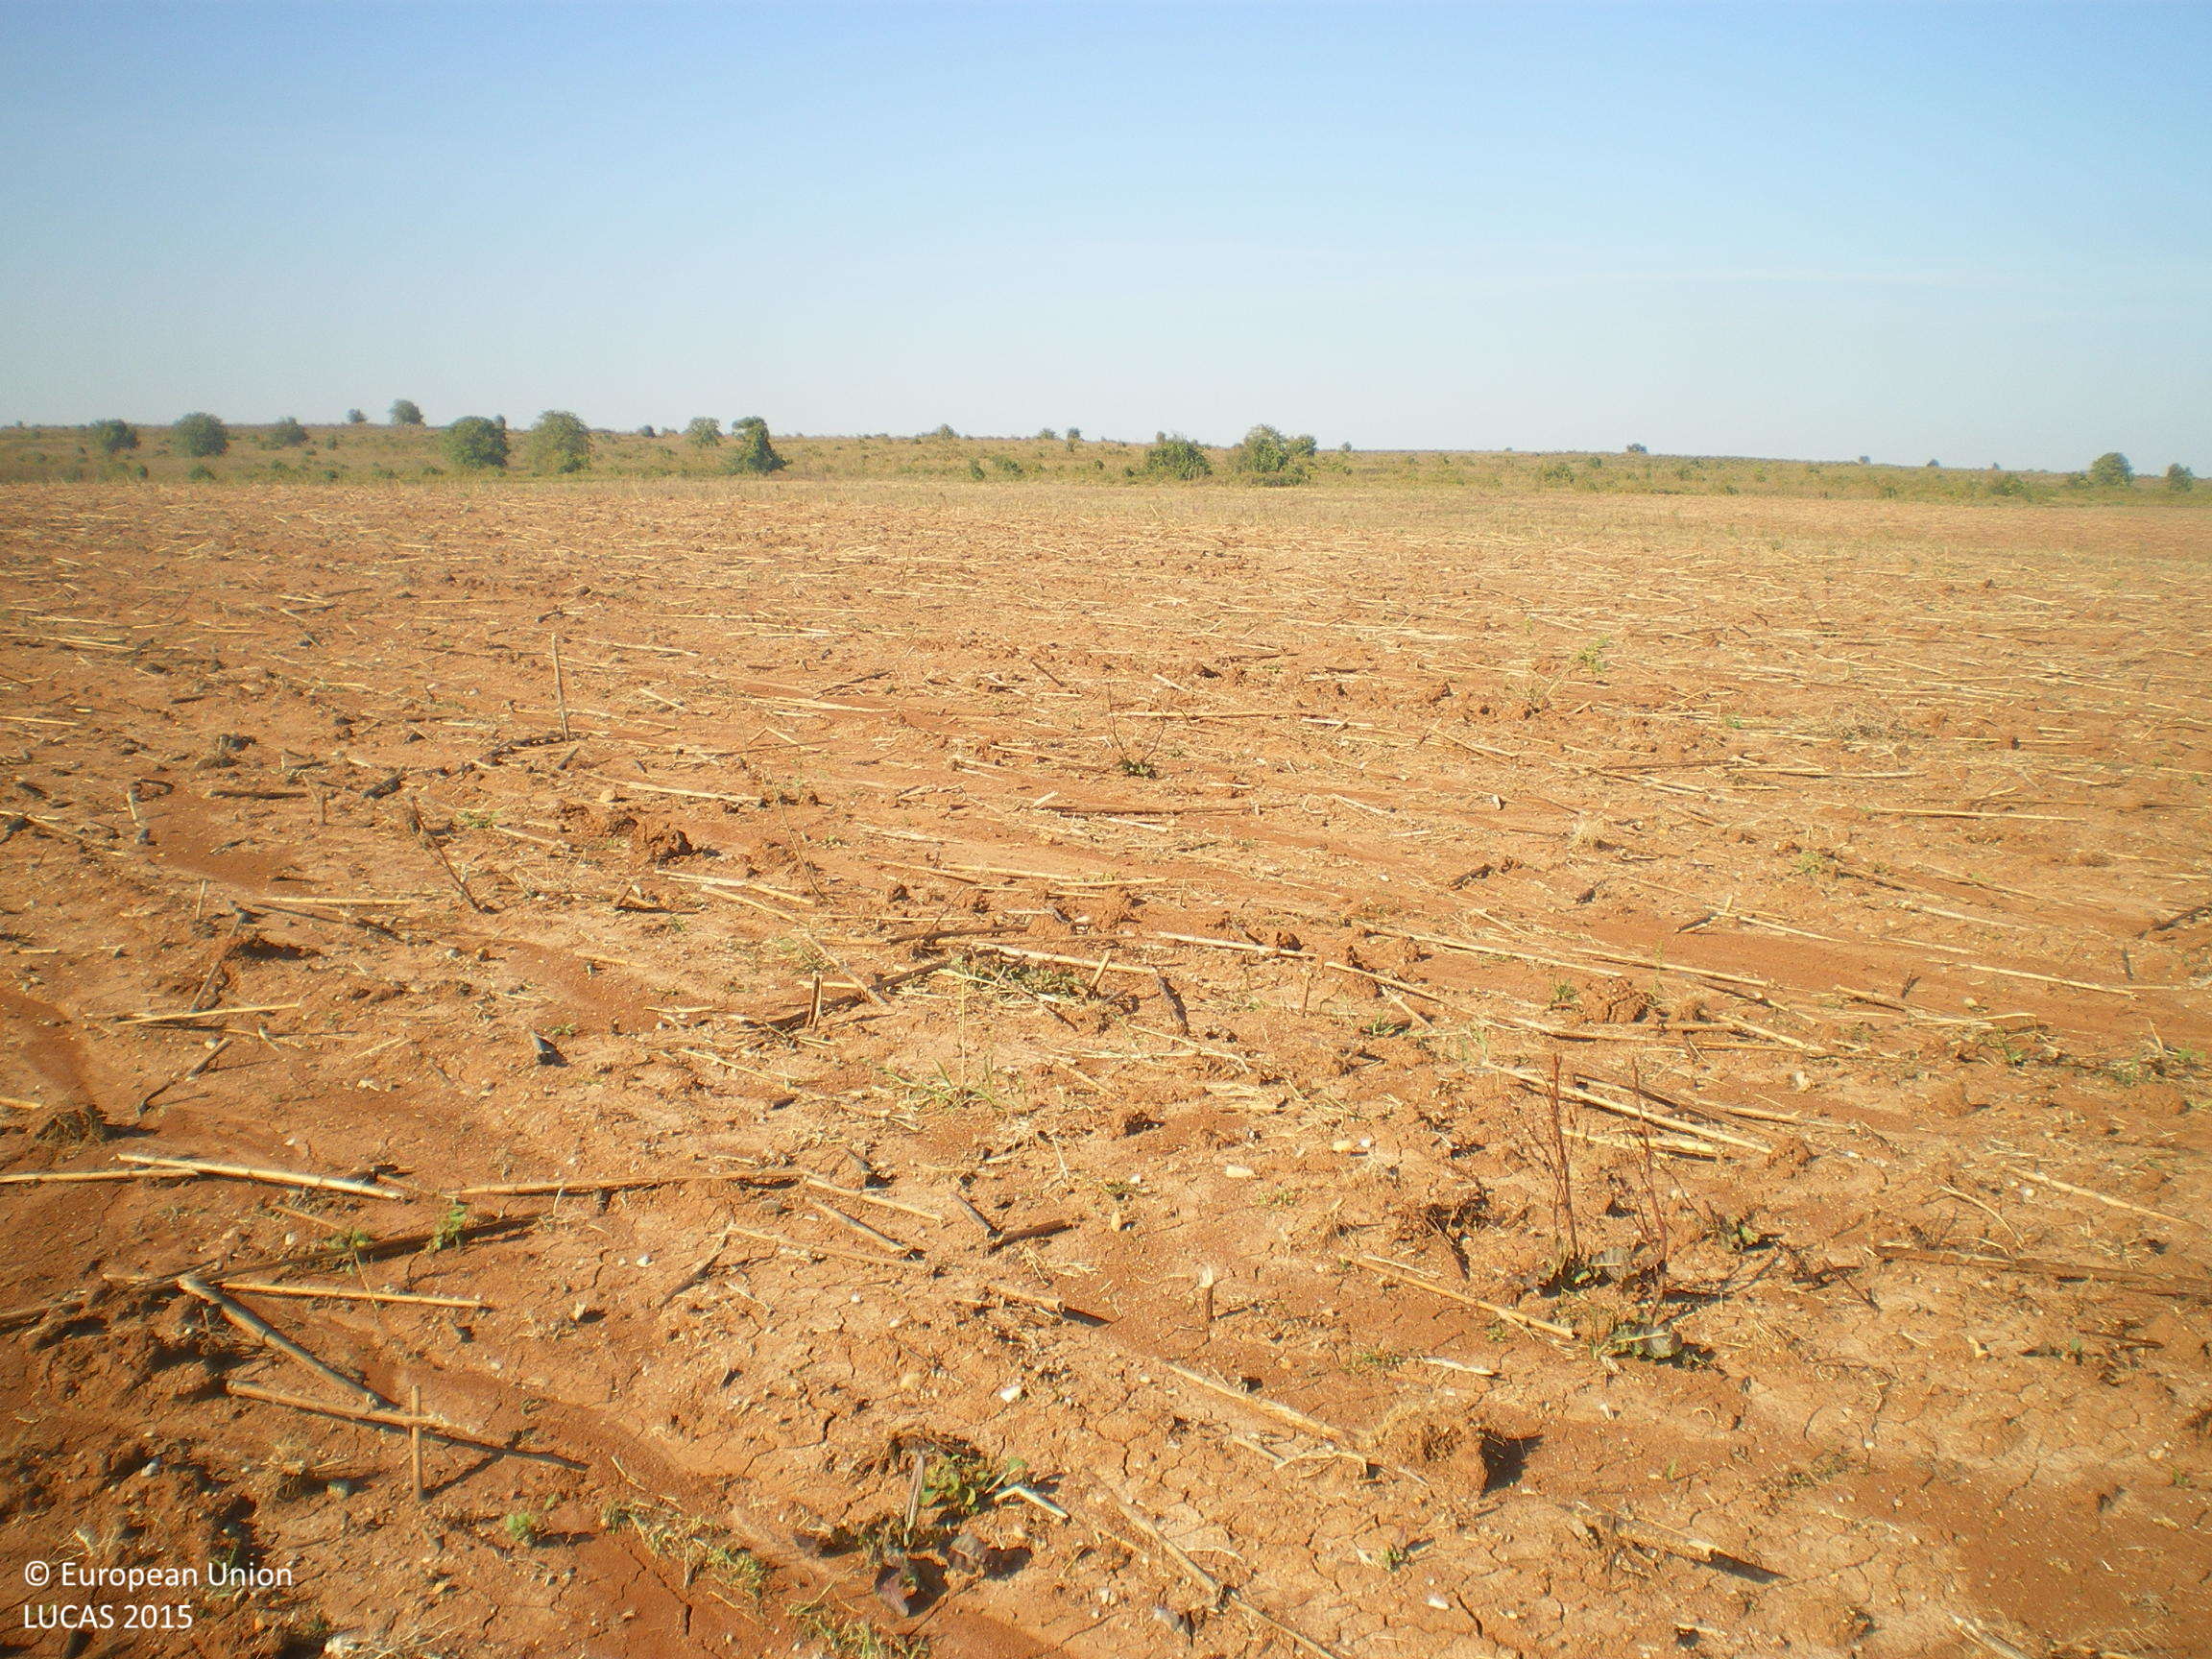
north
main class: Cropland
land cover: Sunflower
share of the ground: < 10 %
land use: Agriculture (excluding fallow land and kitchen gardens)
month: September
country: BG
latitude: 41.8265
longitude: 25.8045
